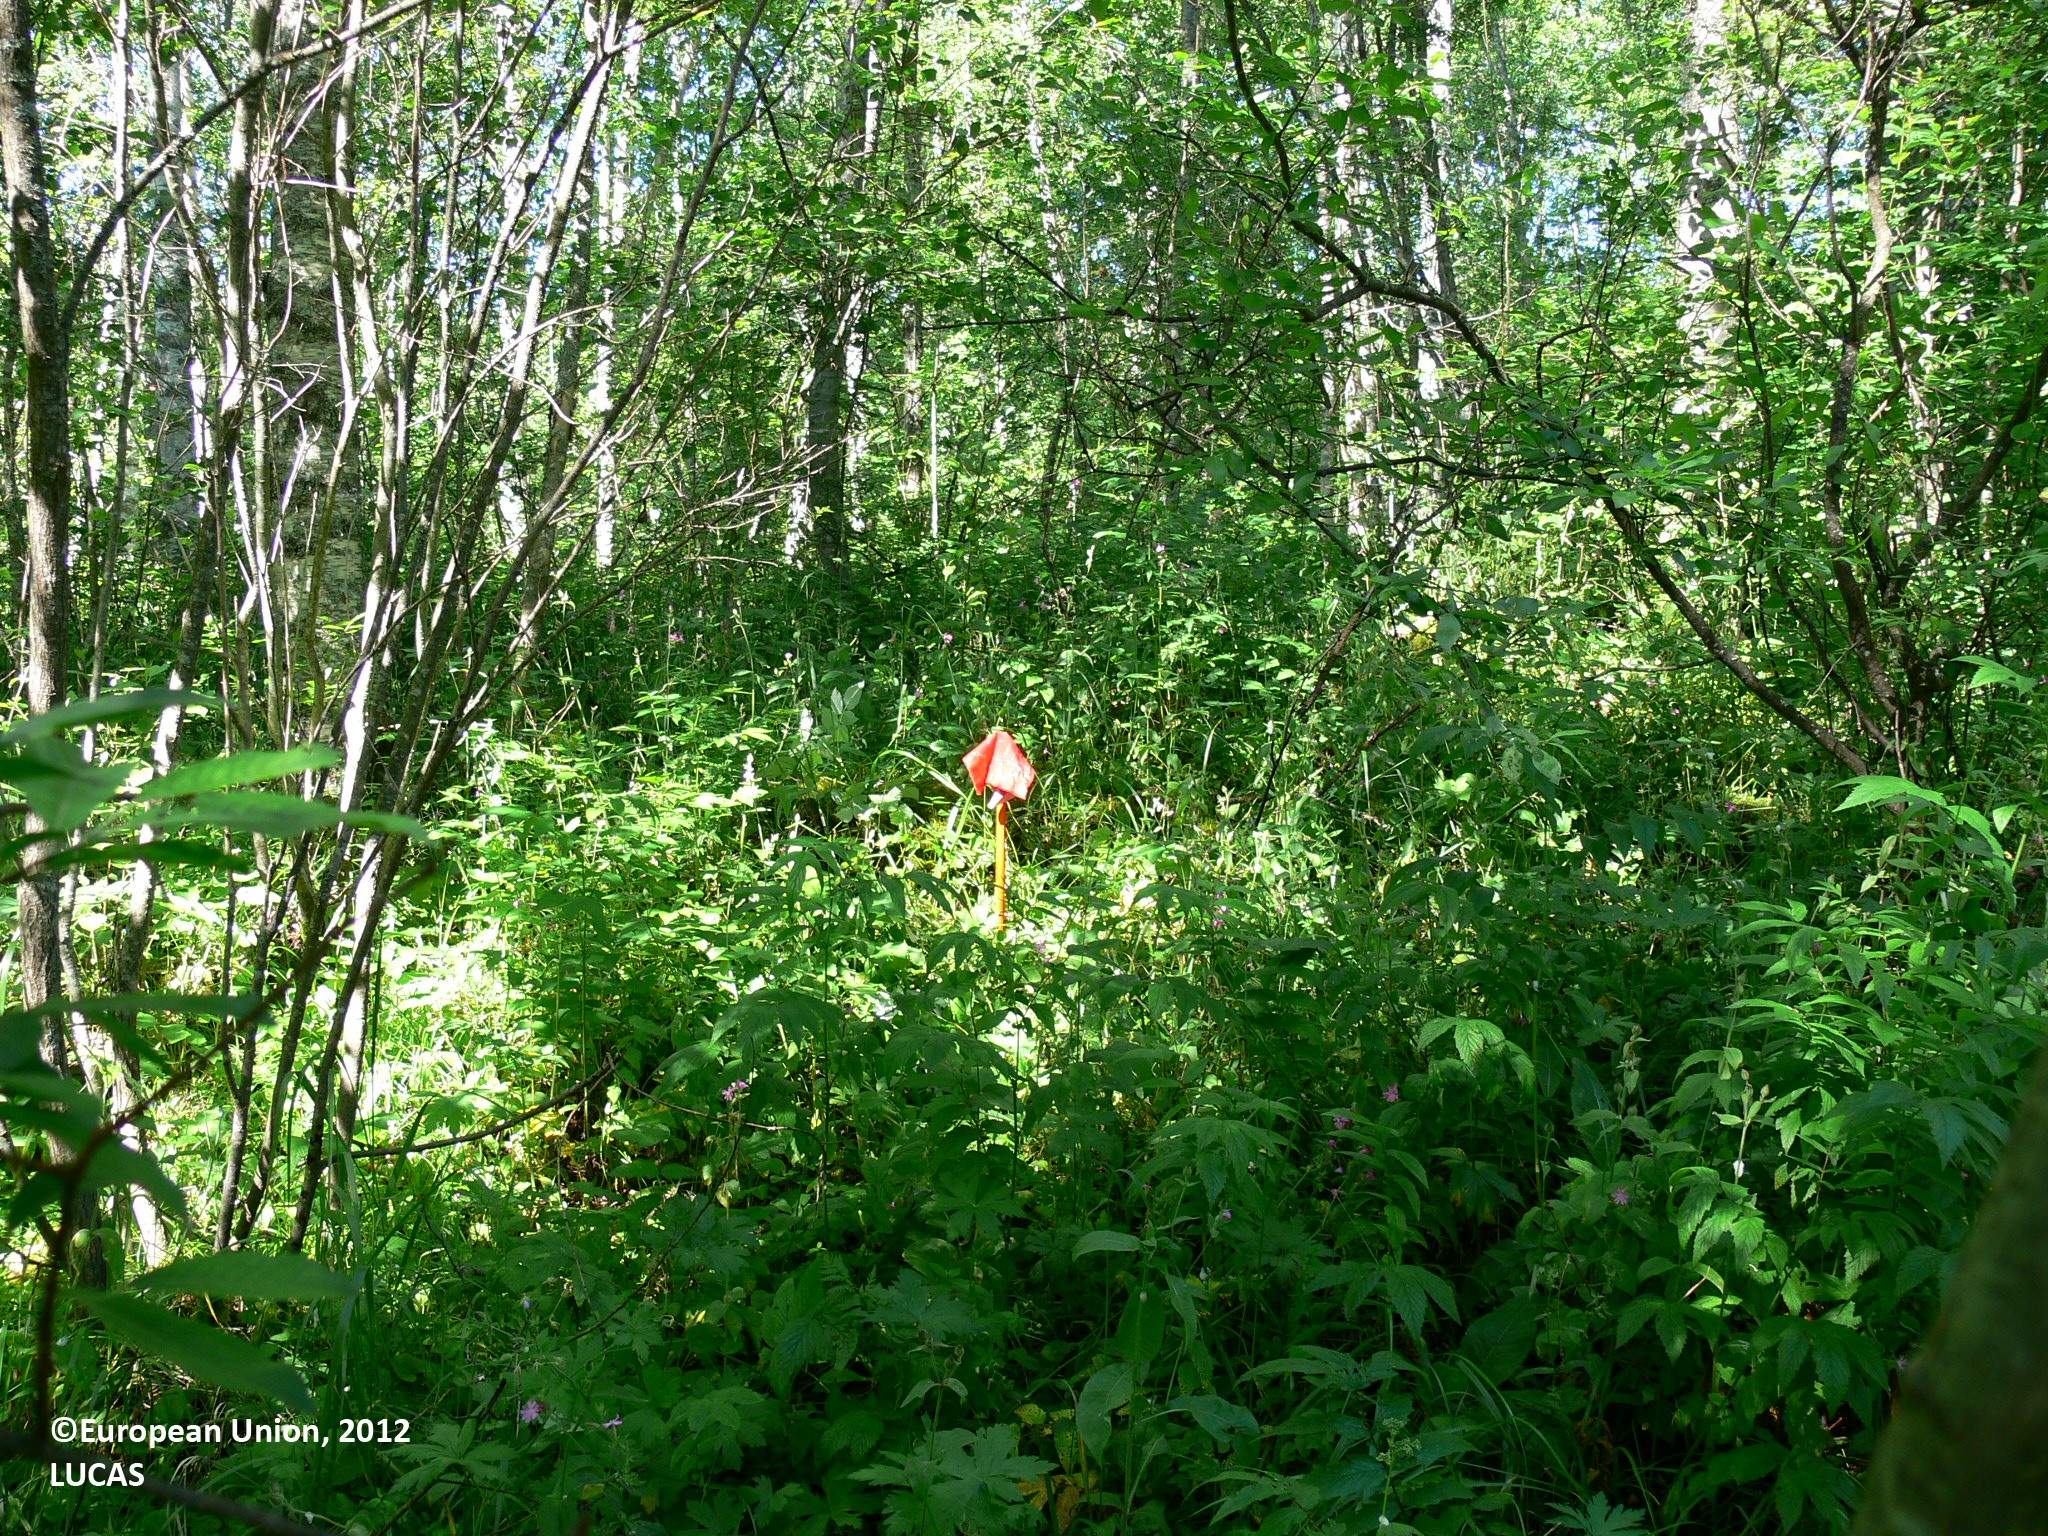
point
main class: Woodland
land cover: Broadleaved woodland
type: boreal forest
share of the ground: > 75 %
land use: Forestry
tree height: > 5 m
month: July
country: FI
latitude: 62.9805
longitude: 29.9226
